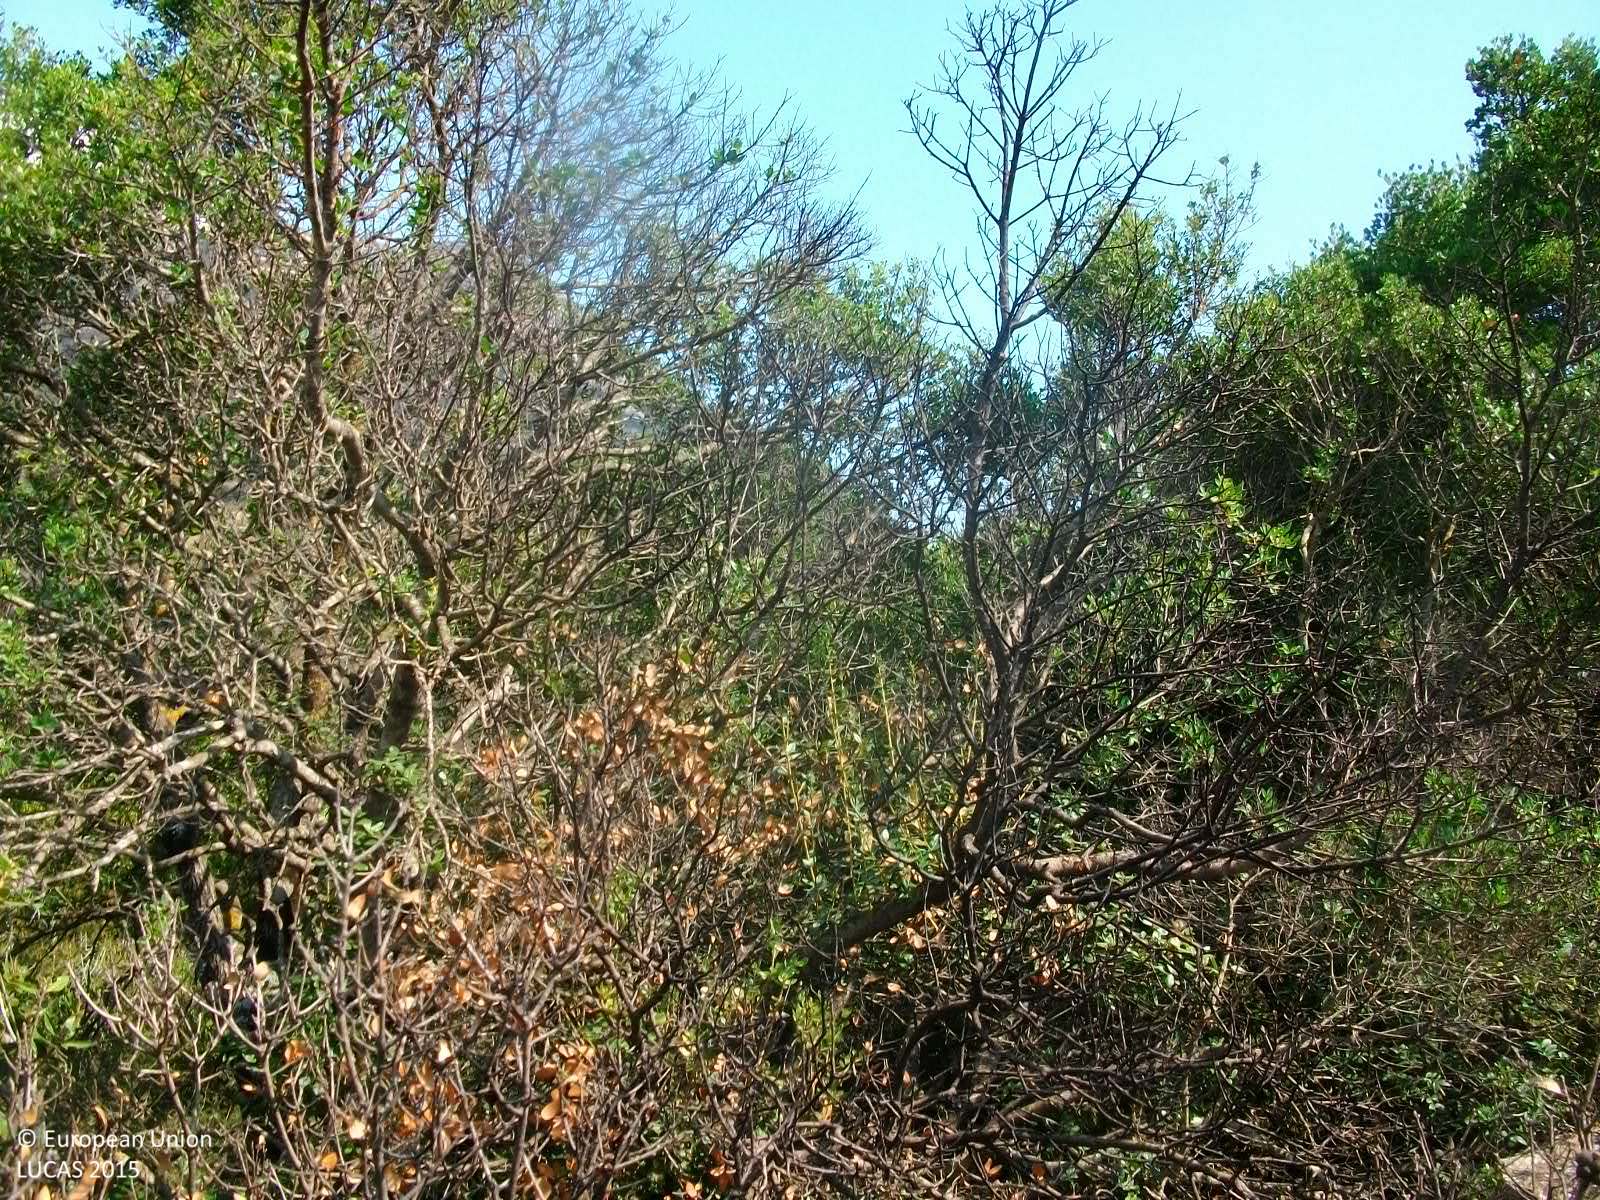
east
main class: Shrubland
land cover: Shrubland with sparse tree cover
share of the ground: > 75 %
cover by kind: shrubs 95 %, broadleaved forest trees 5 %
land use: Semi-natural and natural areas not in use
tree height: > 5 m
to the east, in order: Shrubland with sparse tree cover; Rivers and streams; Shrubland with sparse tree cover; Other coniferous woodland; Shrubland with sparse tree cover; Olive groves; Grass margins; Tracks; Grass margins; Shrubland without tree cover
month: August
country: GR
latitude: 37.1979
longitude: 21.9082
